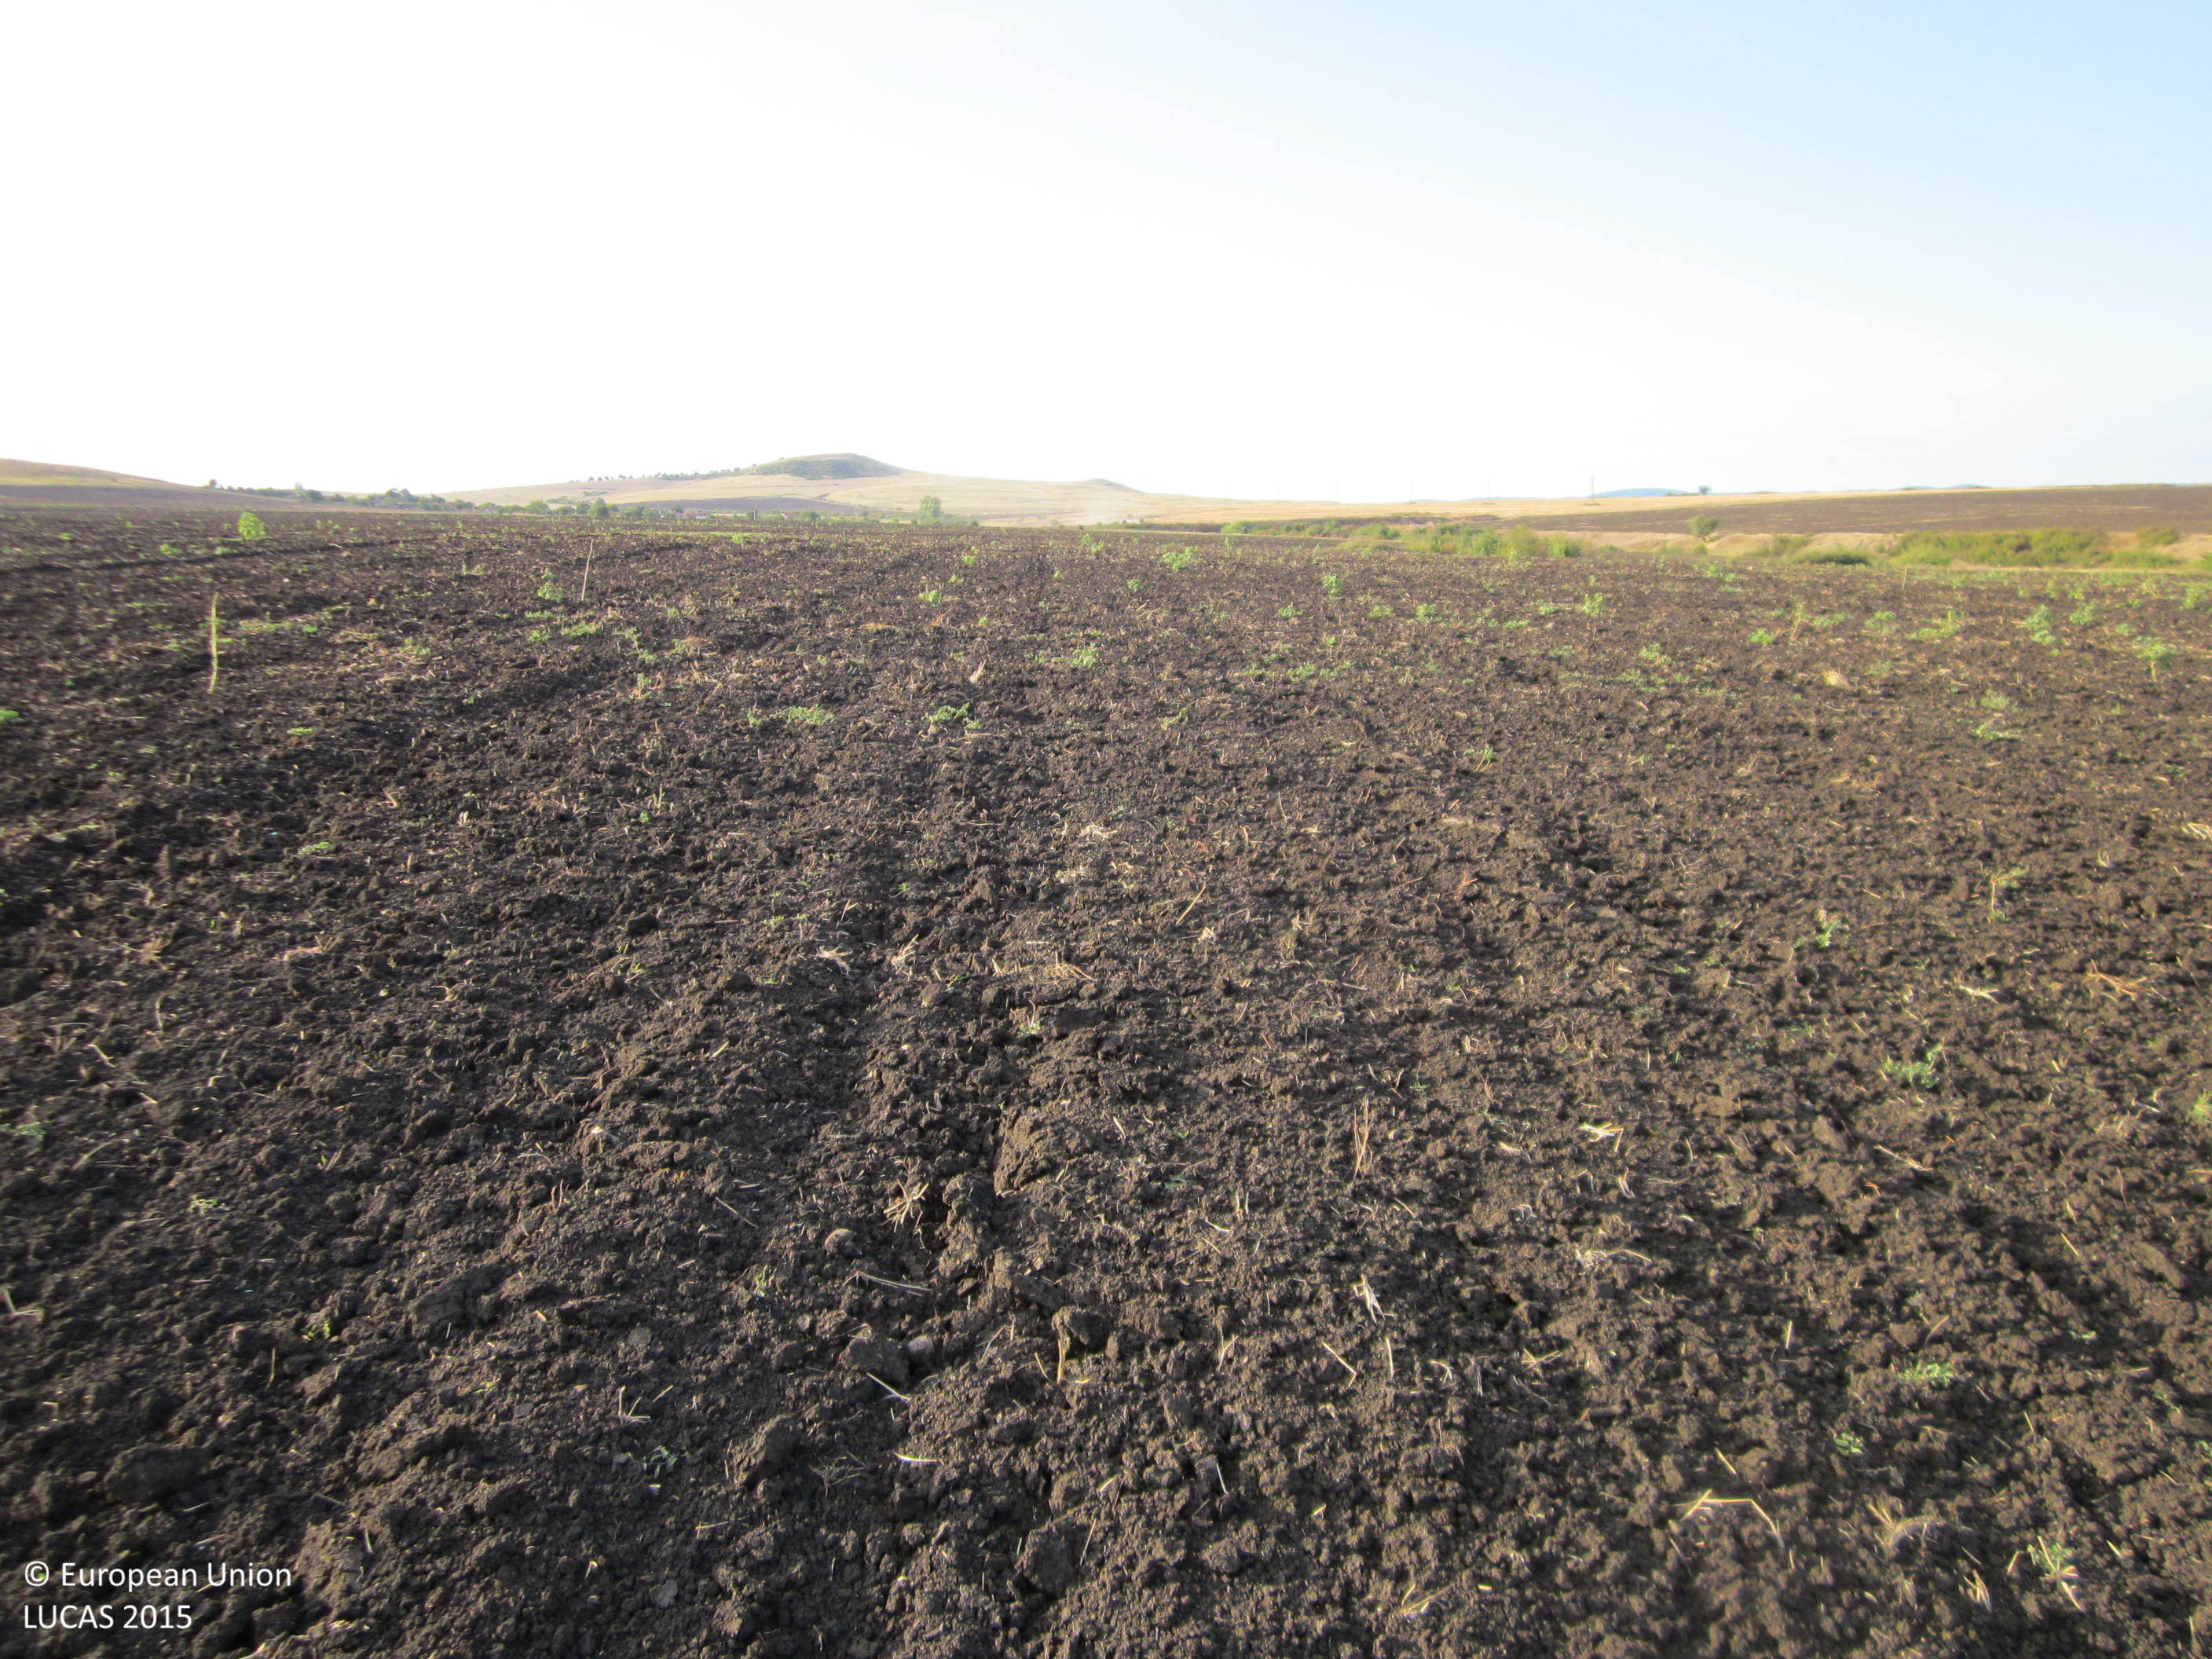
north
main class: Cropland
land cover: Sunflower
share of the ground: < 10 %
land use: Agriculture (excluding fallow land and kitchen gardens)
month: September
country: BG
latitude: 42.6207
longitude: 27.1171
